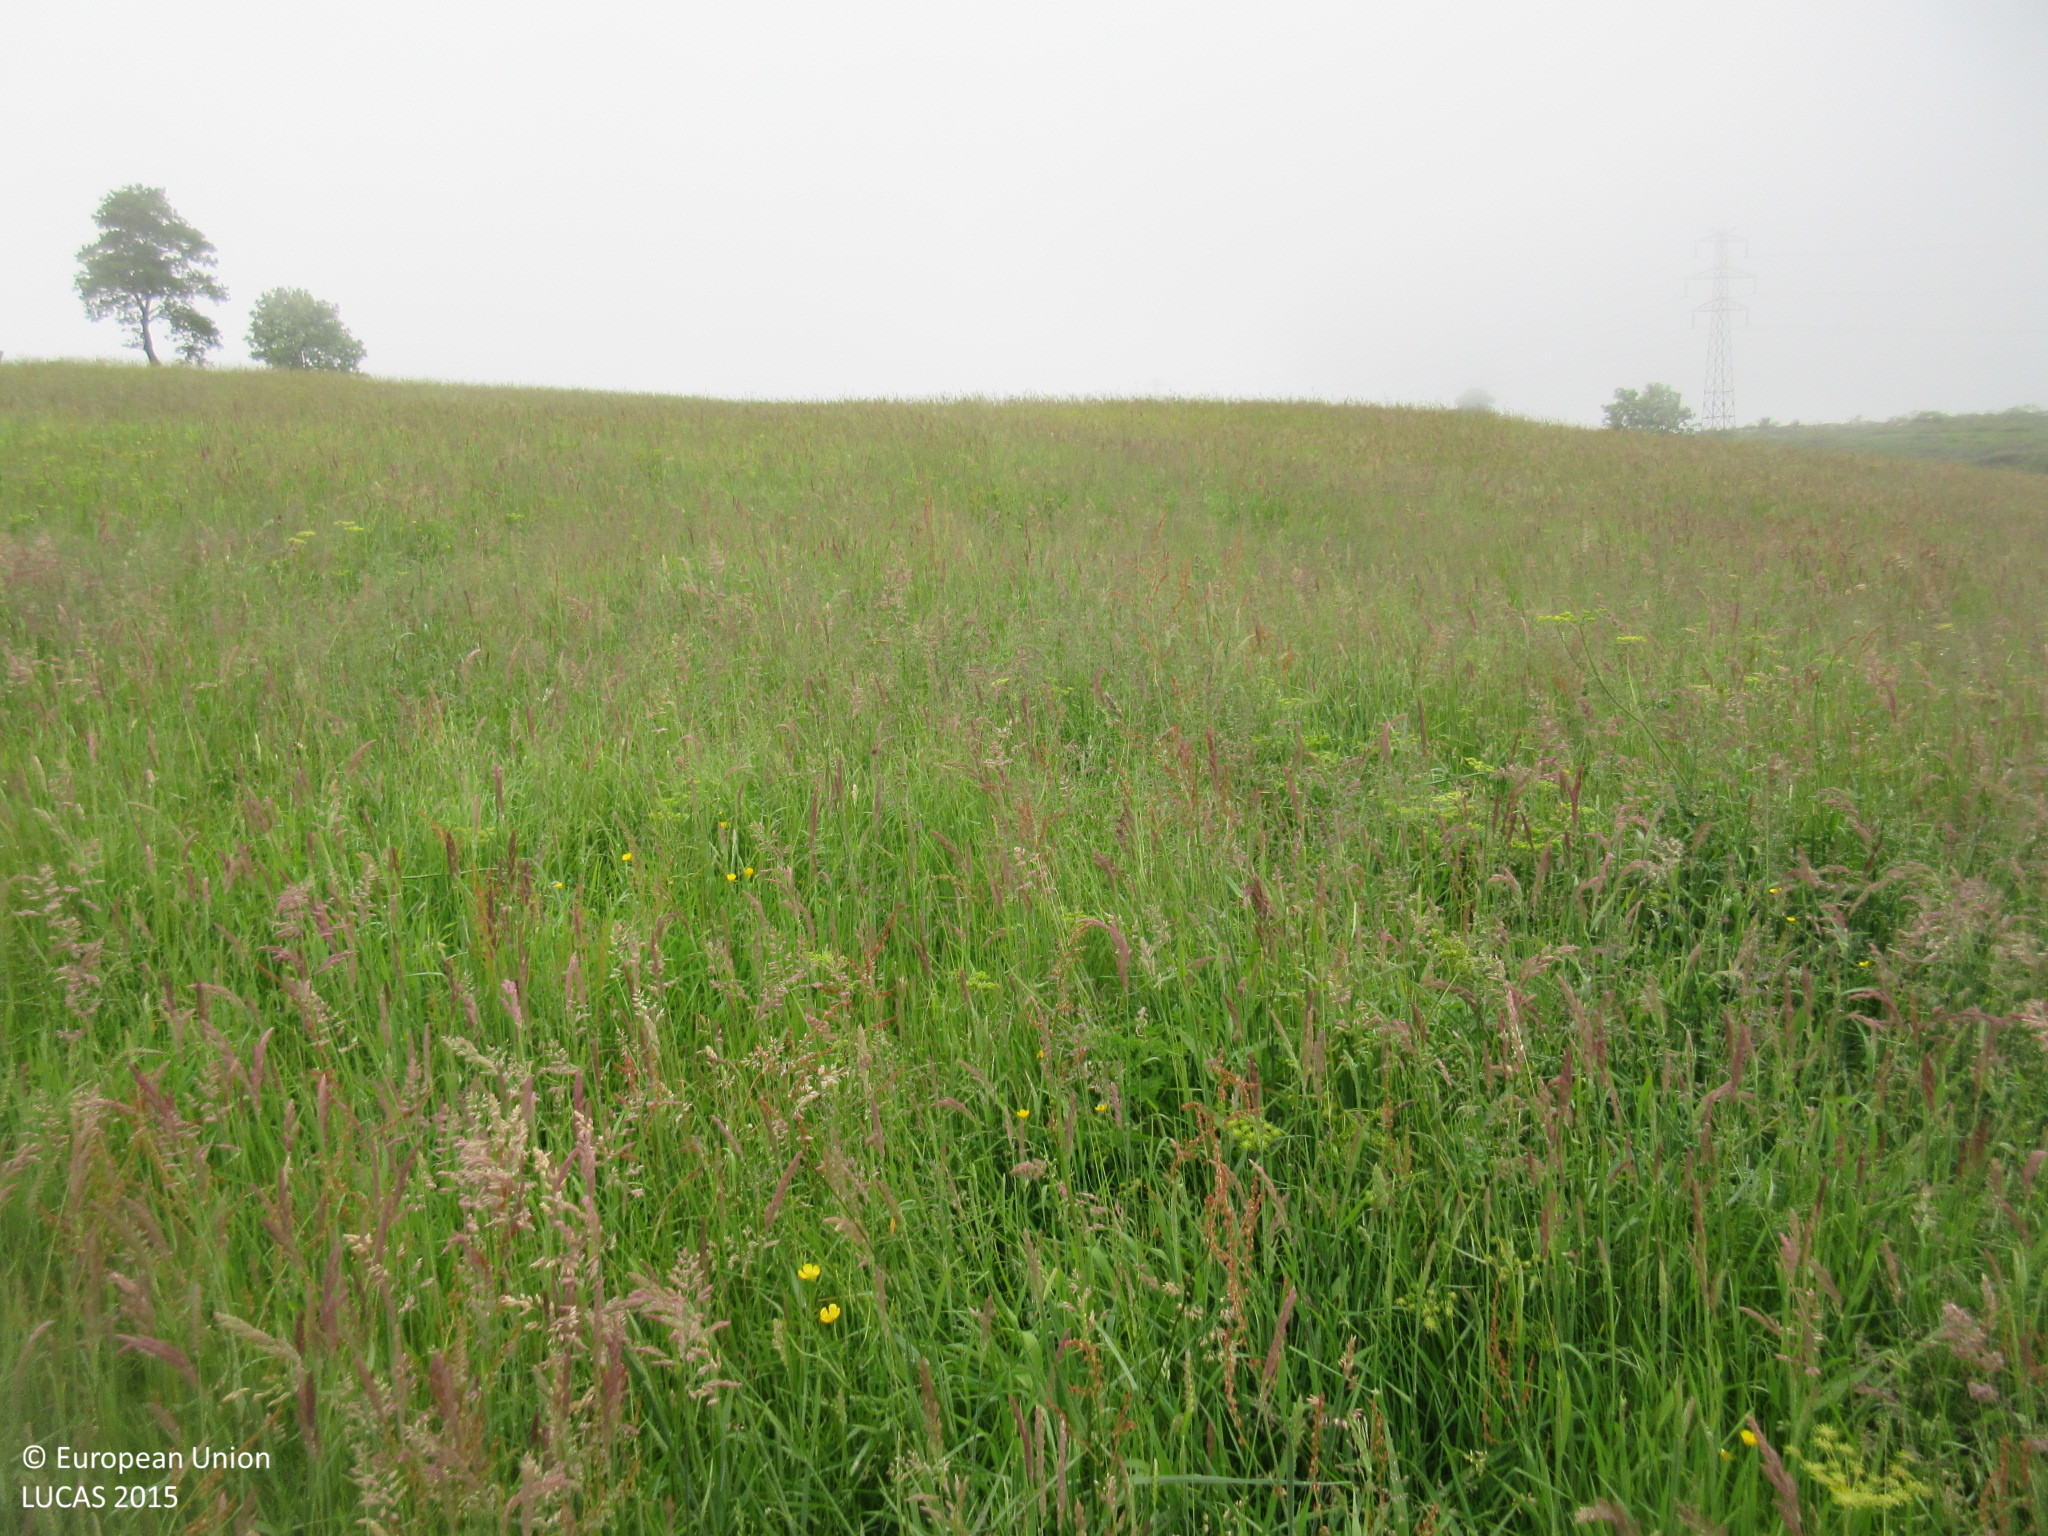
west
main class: Grassland
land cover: Grassland without tree/shrub cover
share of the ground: > 75 %
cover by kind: herbaceous plants 100 %
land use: Agriculture (excluding fallow land and kitchen gardens)
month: June
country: ES
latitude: 43.3635
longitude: -6.3002
